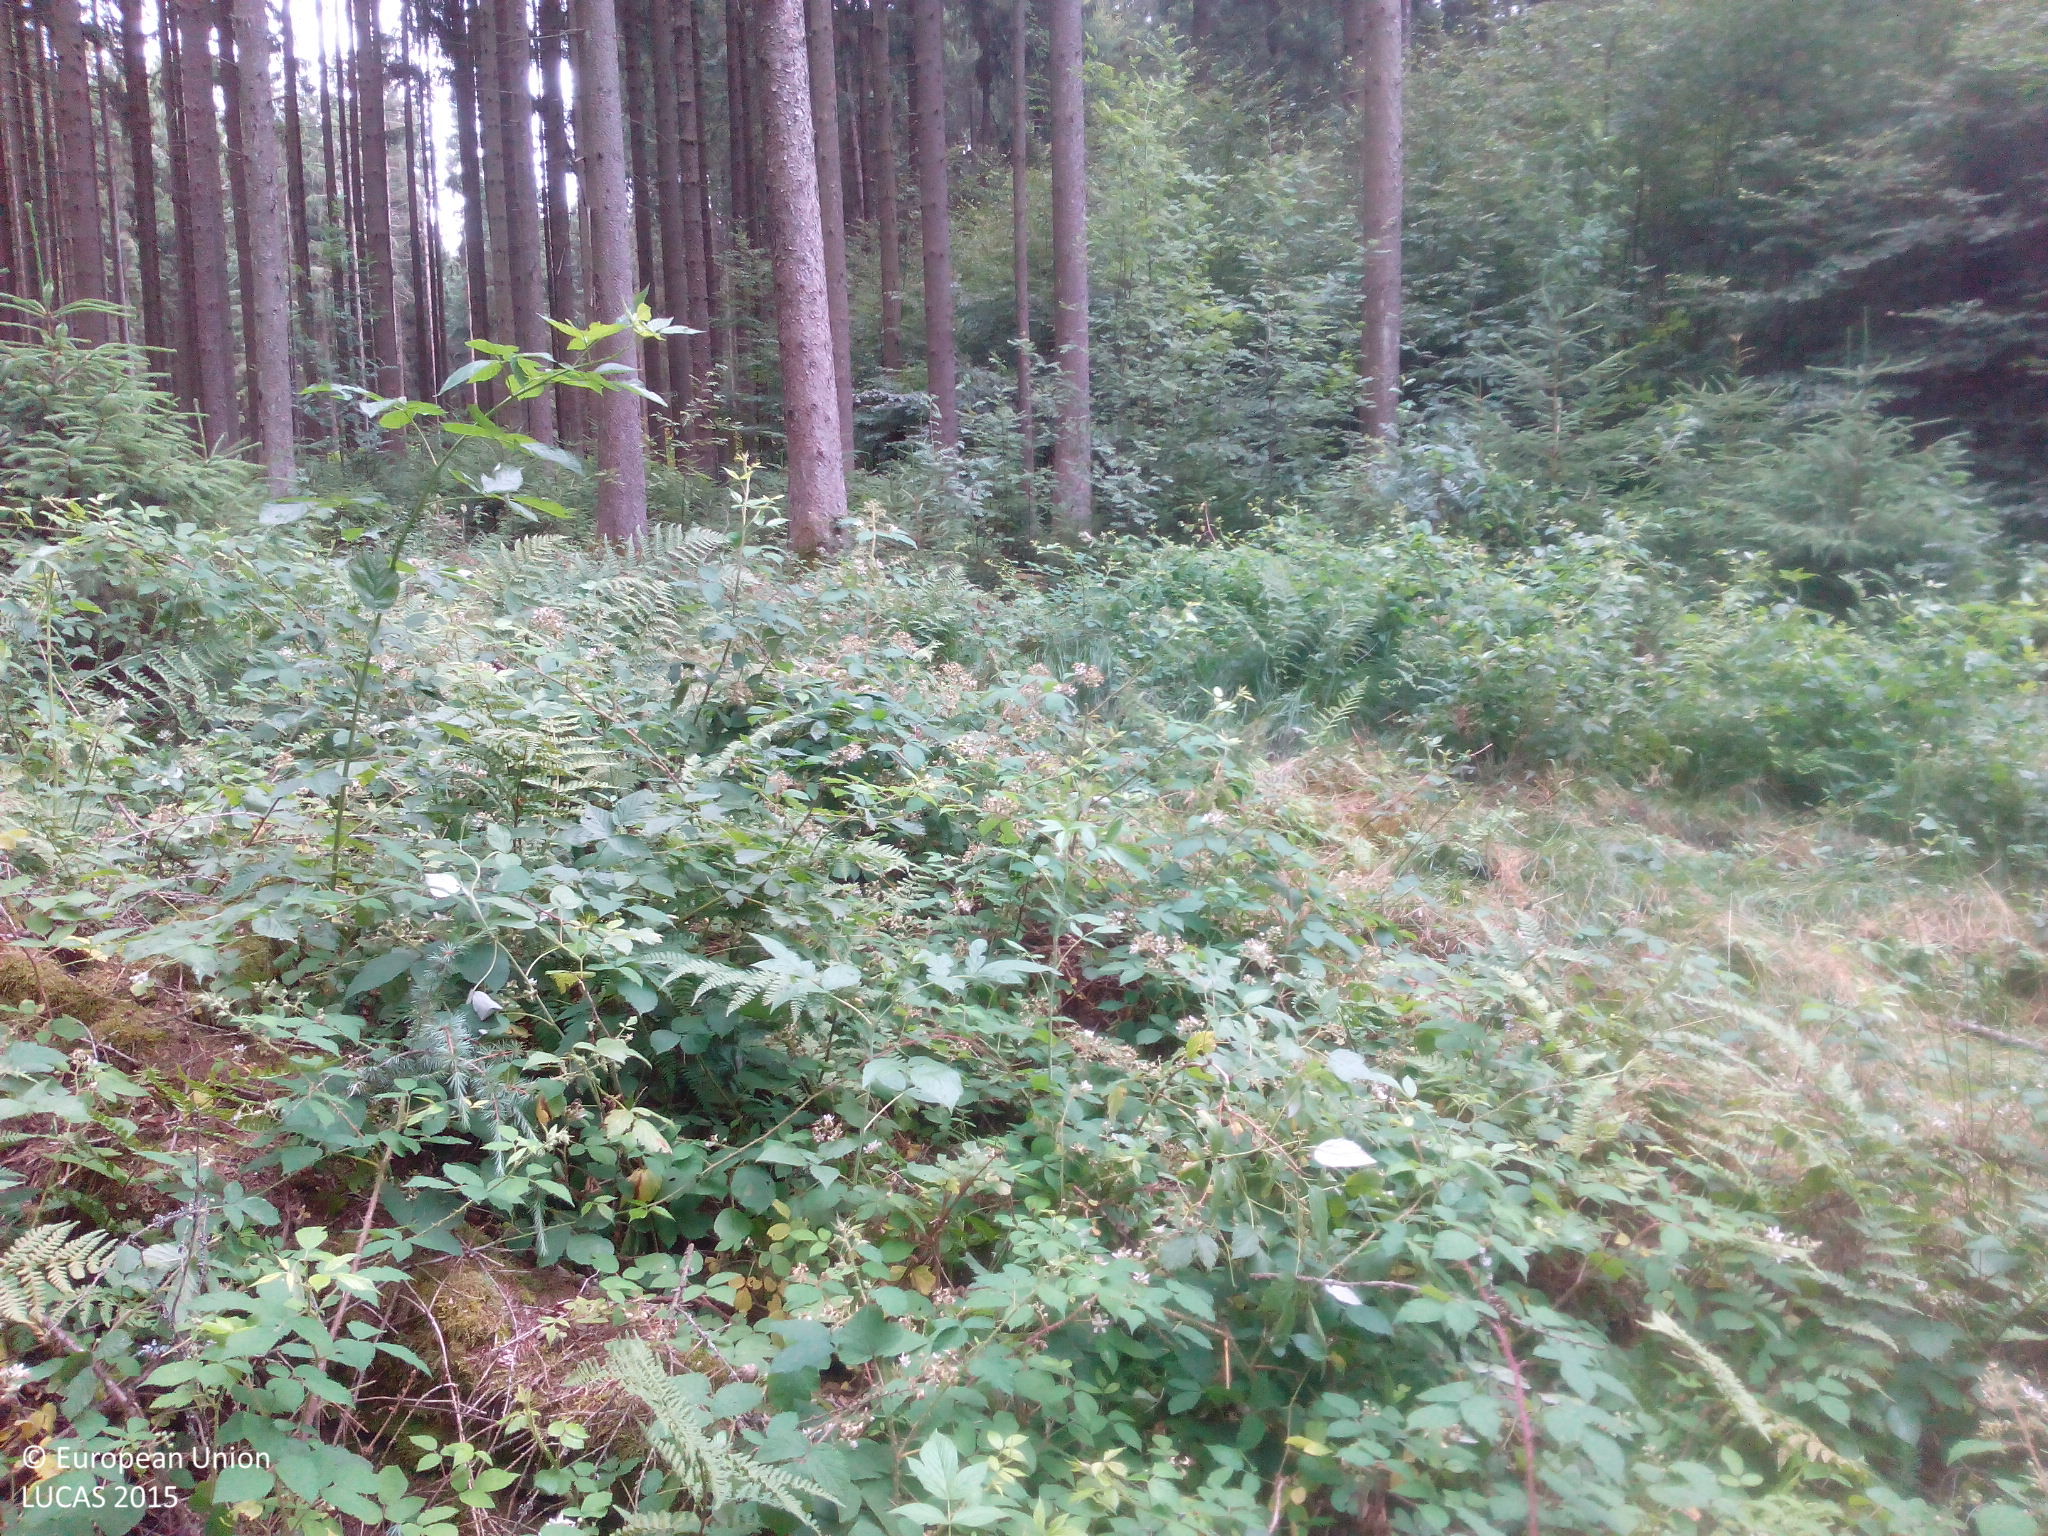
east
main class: Woodland
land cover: Other coniferous woodland
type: hemiboreal forest and nemoral coniferous forest and mixed broadleaved-coniferous forest
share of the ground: 50 - 75 %
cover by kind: coniferous forest trees 60 %, shrubs 20 %, lichens and mosses 15 %, herbaceous plants 5 %
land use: Forestry
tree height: > 5 m
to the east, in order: Other coniferous woodland; Tracks; Spruce dominated coniferous woodland
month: July
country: DE
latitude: 48.8621
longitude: 11.4307
